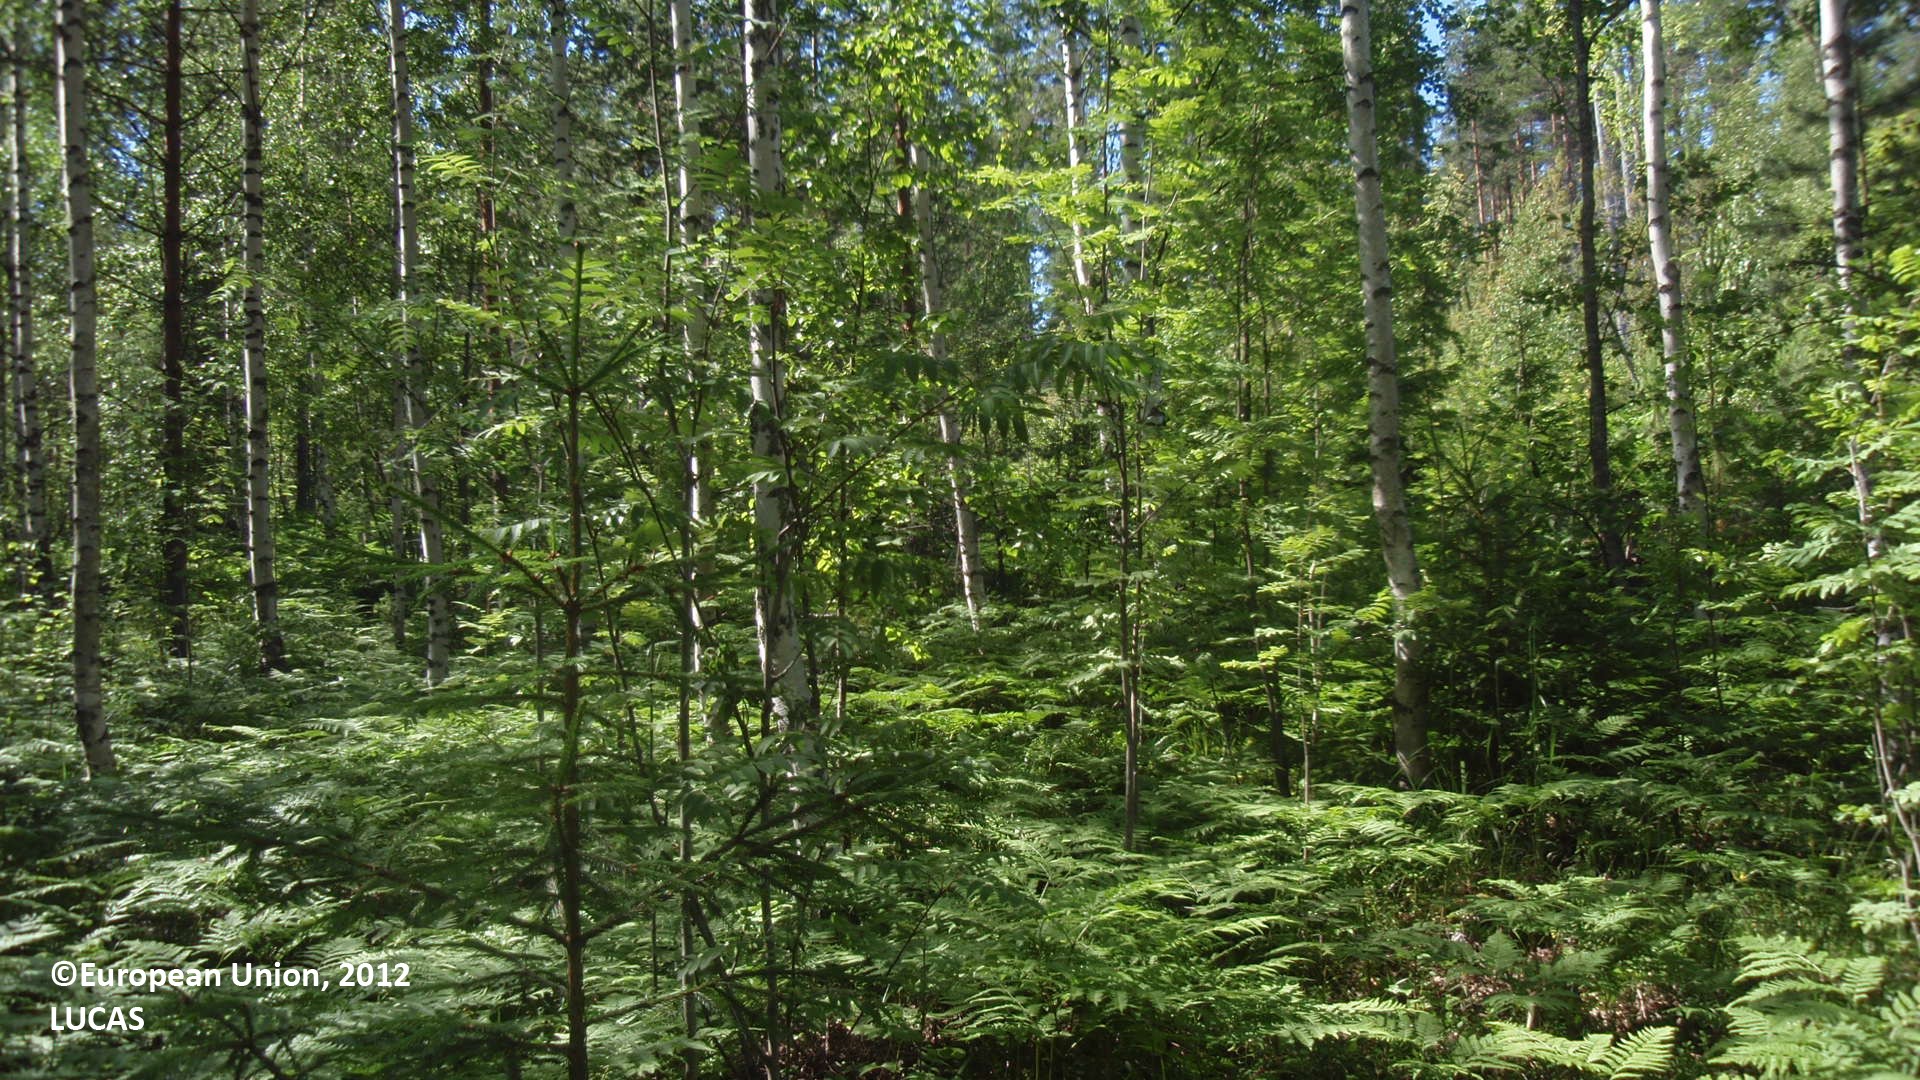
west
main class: Woodland
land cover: Other mixed woodland
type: boreal forest
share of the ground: > 75 %
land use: Forestry
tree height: > 5 m
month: July
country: FI
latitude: 61.7327
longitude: 28.3173
